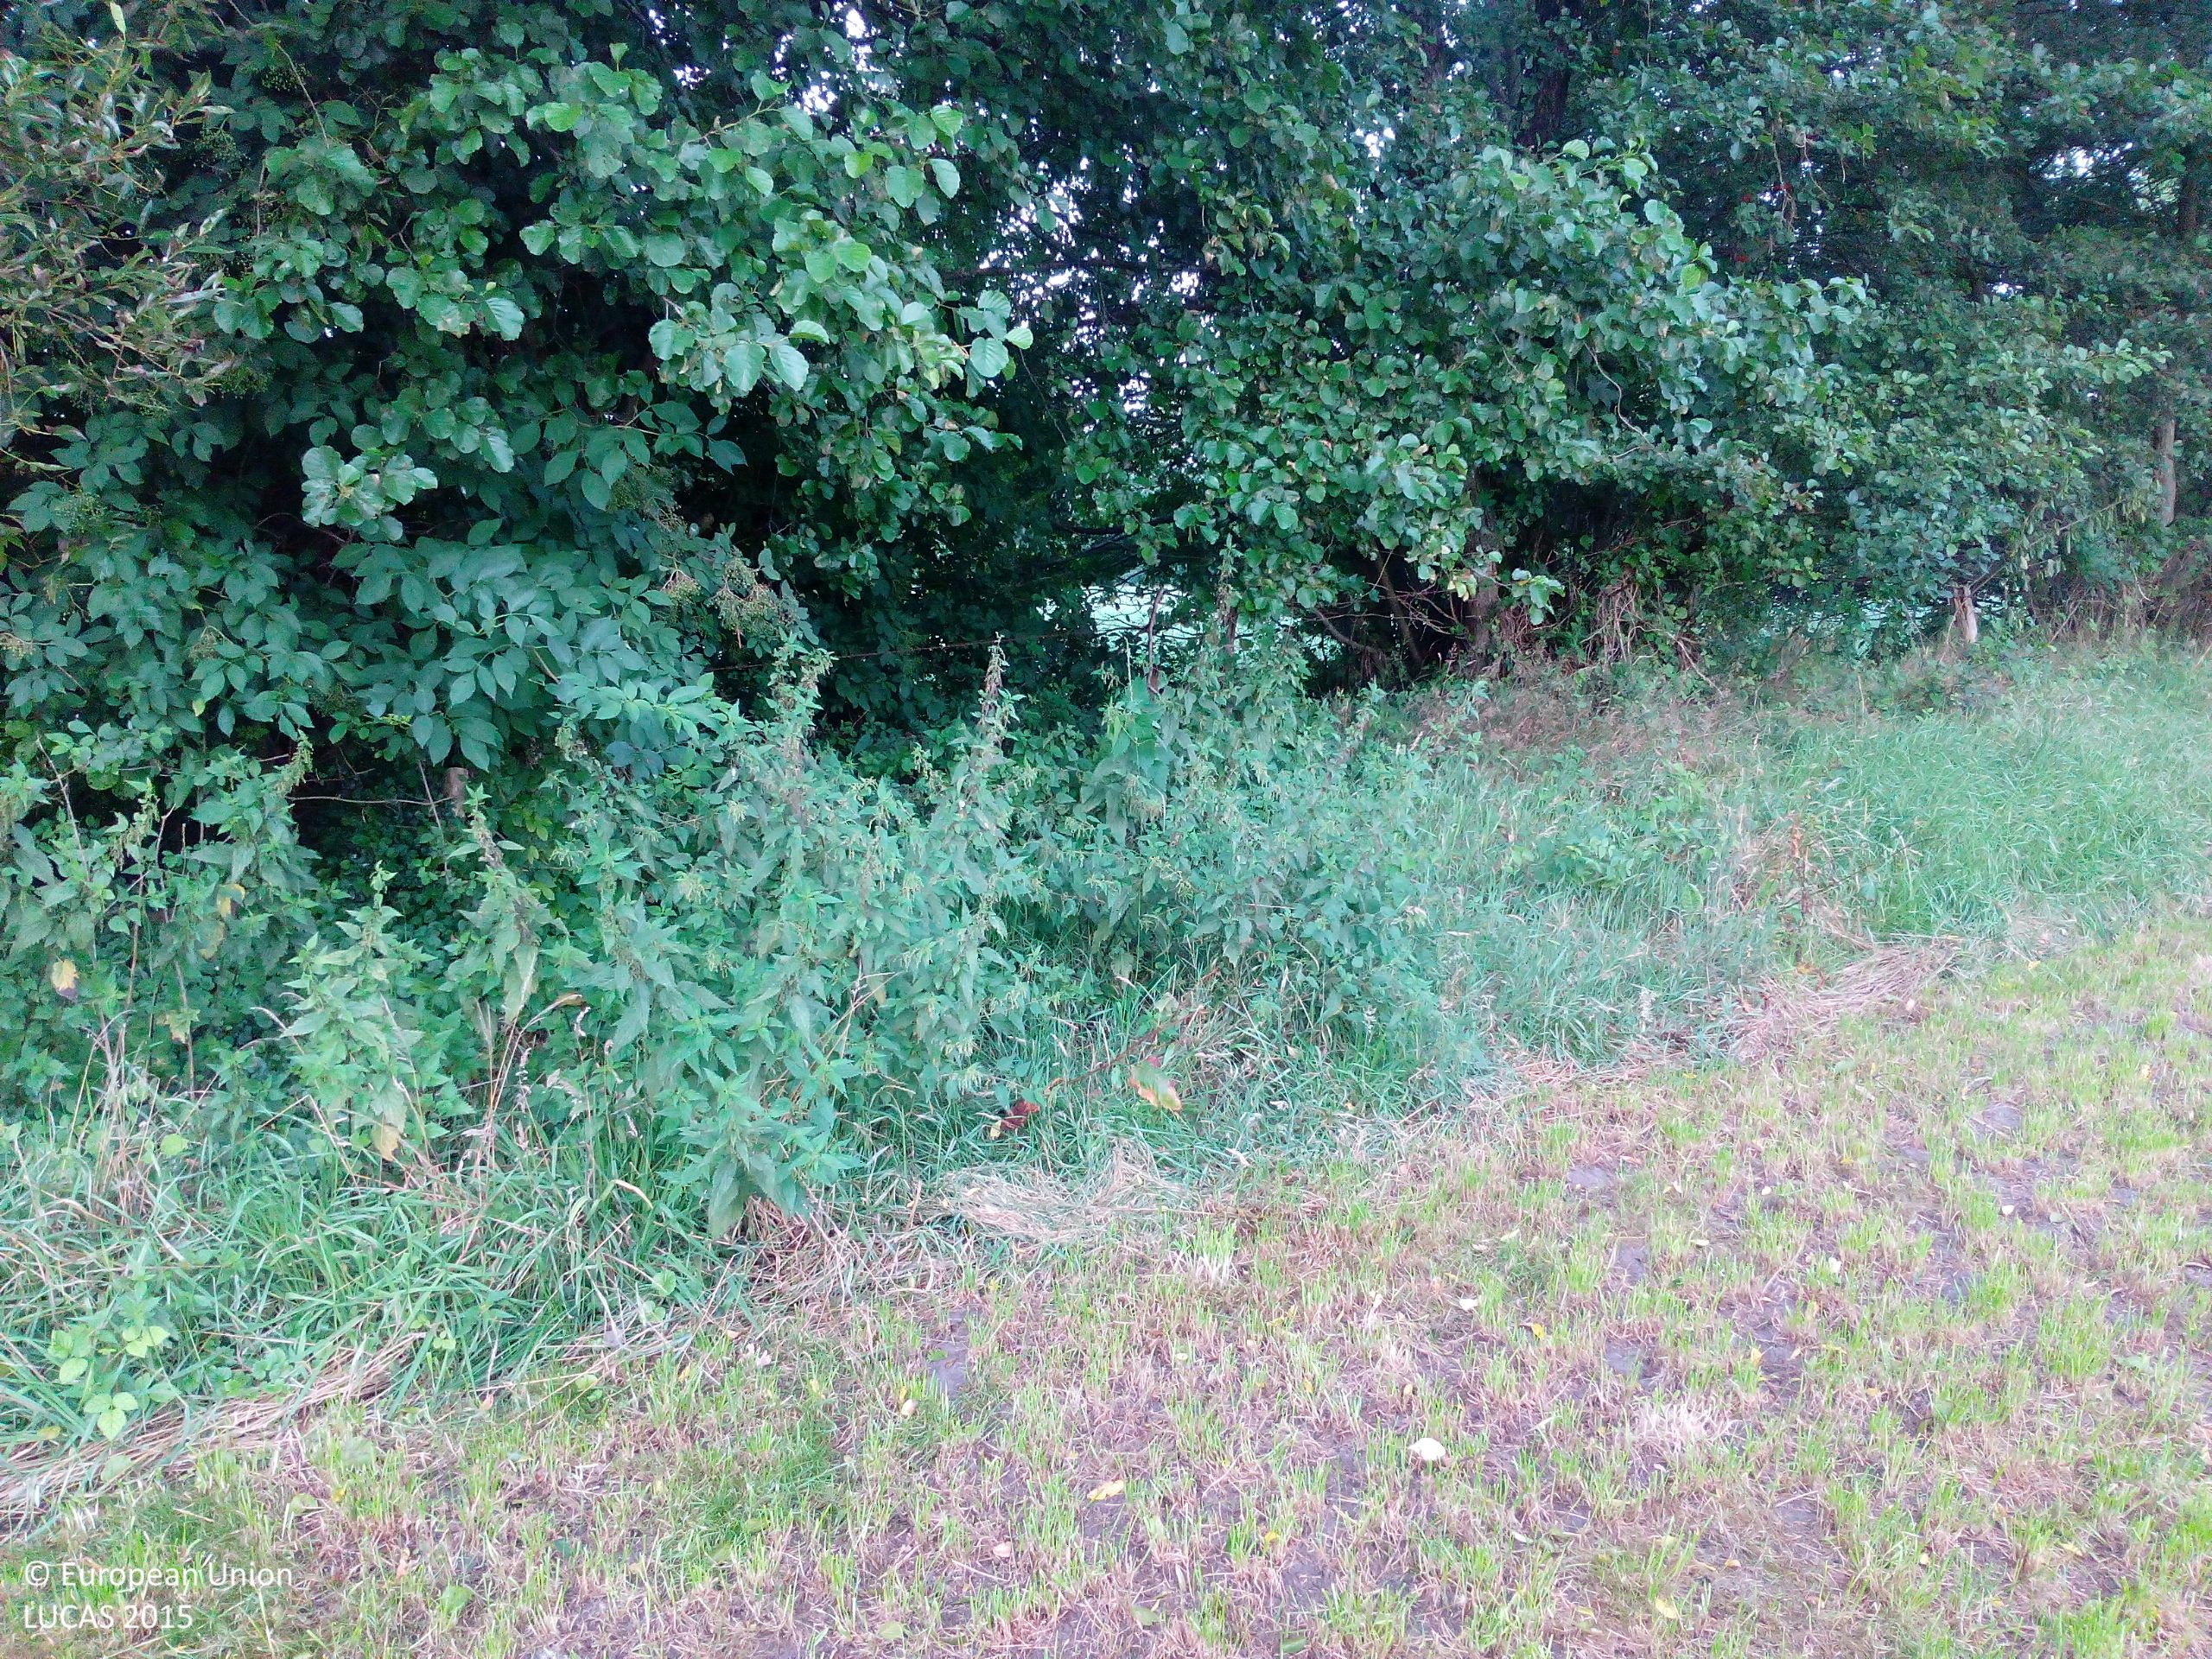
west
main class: Grassland
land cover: Grassland without tree/shrub cover
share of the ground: > 75 %
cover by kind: herbaceous plants 80 %, unconsolidated bare surface 20 %
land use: Agriculture (excluding fallow land and kitchen gardens)
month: August
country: DE
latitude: 53.8692
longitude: 9.9240
